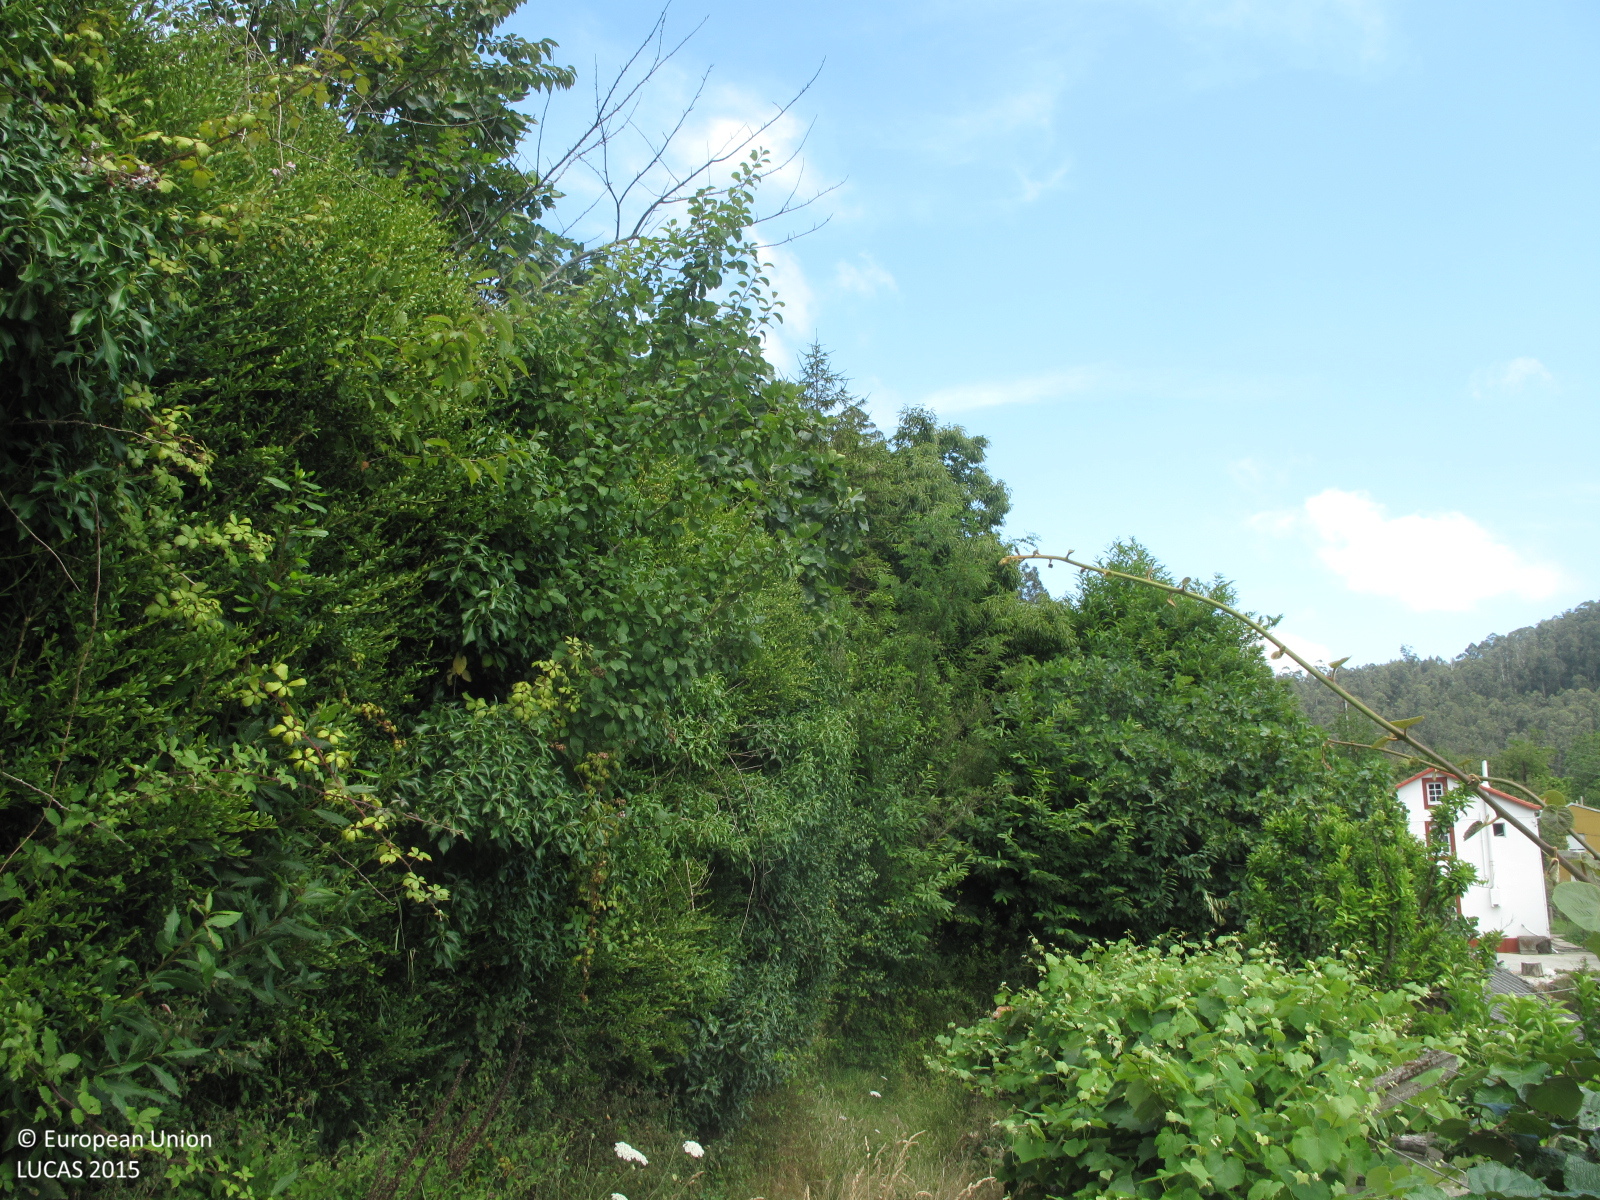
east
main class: Grassland
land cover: Grassland with sparse tree/shrub cover
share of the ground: > 75 %
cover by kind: herbaceous plants 95 %, broadleaved forest trees 5 %
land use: Residential
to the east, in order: Grassland with sparse tree/shrub cover; Dry stone walls; Tracks; Broadleaved woodland
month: July
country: ES
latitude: 43.6395
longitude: -8.0360
